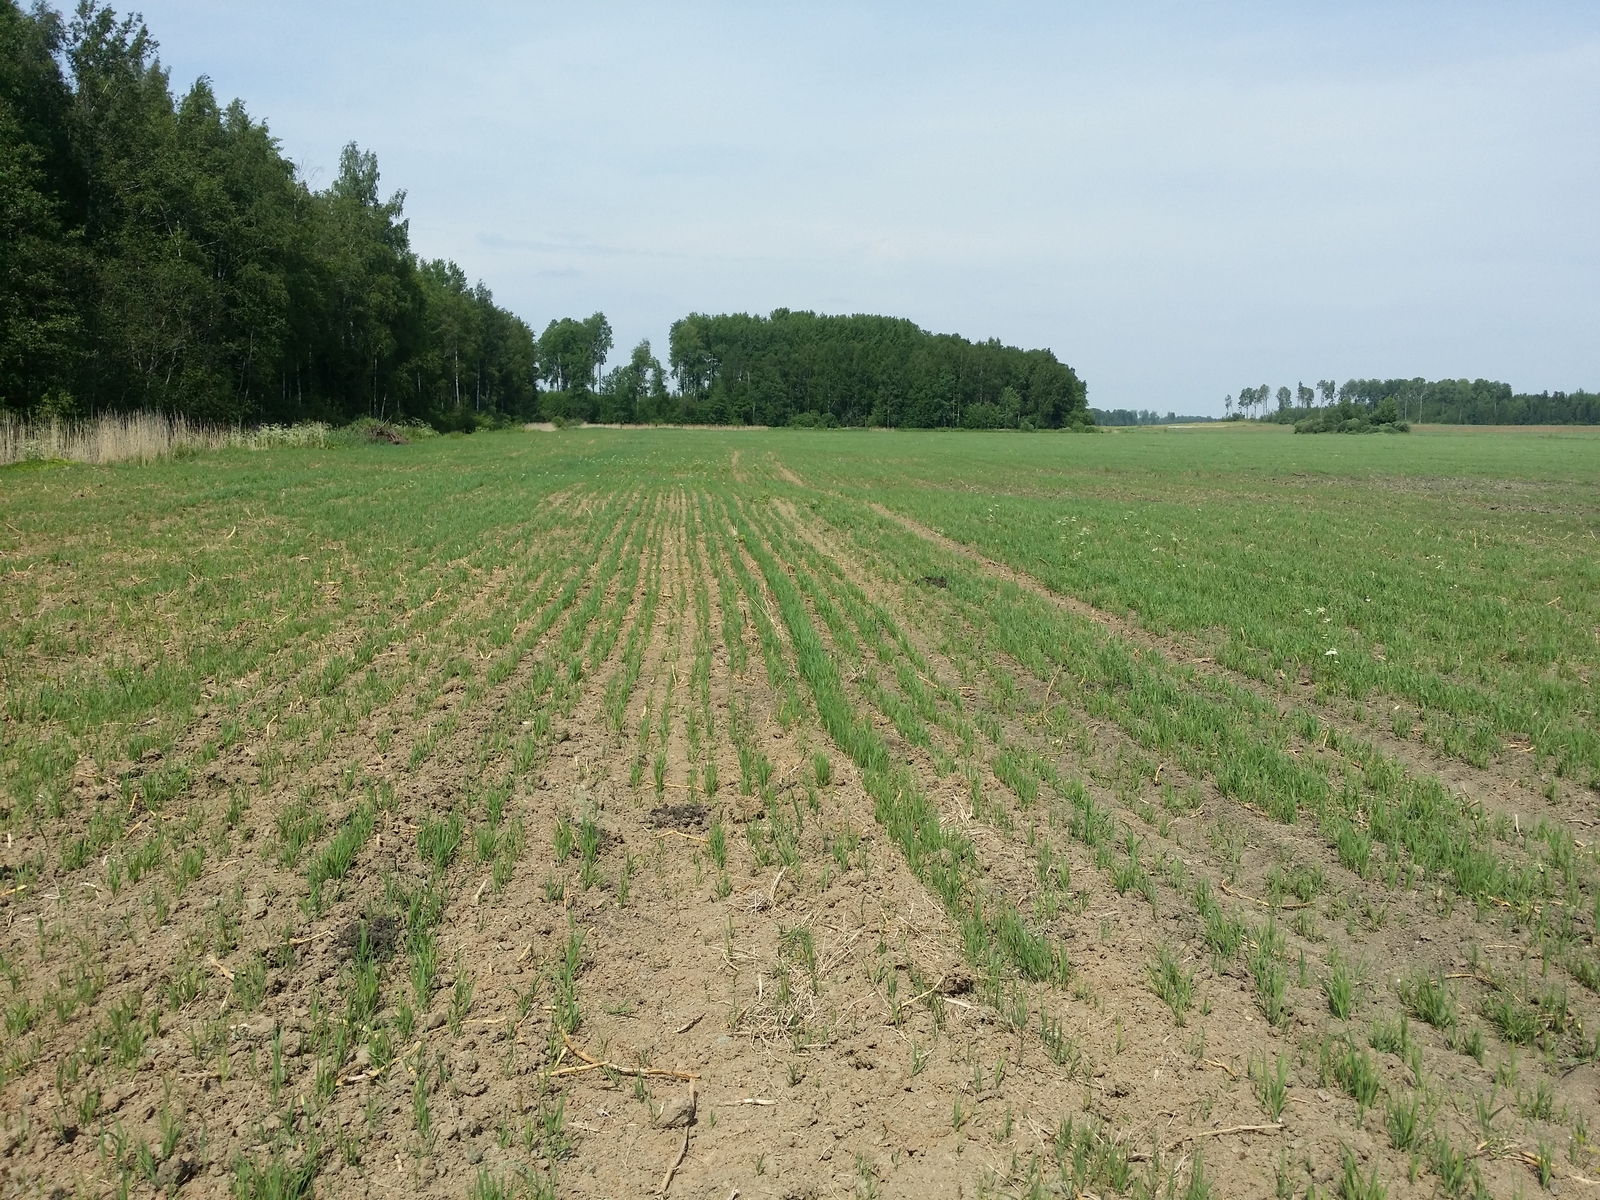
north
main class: Cropland
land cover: Oats
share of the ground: 10 - 25 %
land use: Agriculture (excluding fallow land and kitchen gardens)
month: June
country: LV
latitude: 57.4437
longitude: 26.5219
